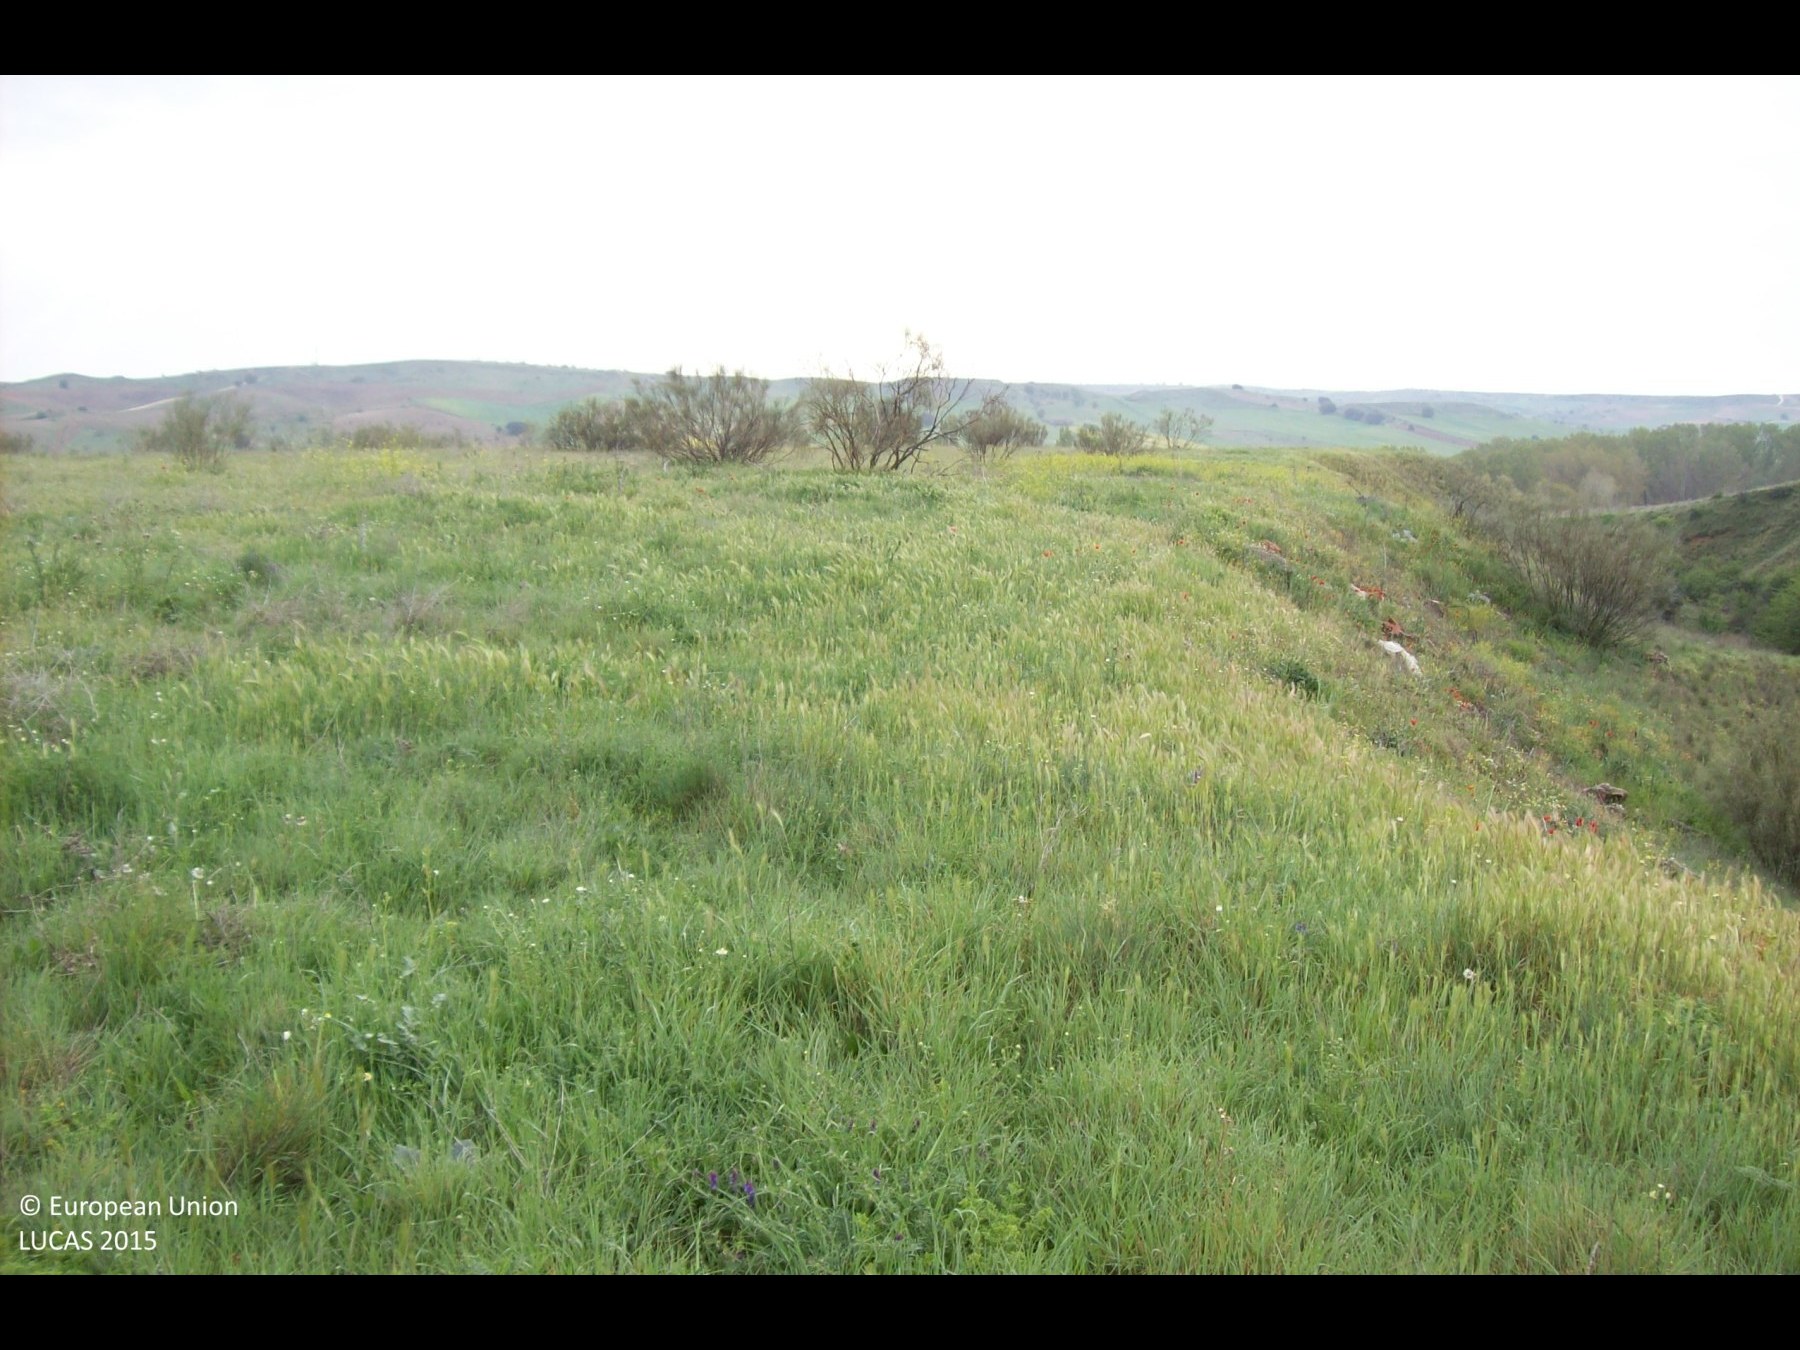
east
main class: Grassland
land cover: Grassland without tree/shrub cover
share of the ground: > 75 %
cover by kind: herbaceous plants 100 %
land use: Semi-natural and natural areas not in use
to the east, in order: Grassland without tree/shrub cover; Grassland with sparse tree/shrub cover; Shrubland without tree cover; Grassland with sparse tree/shrub cover
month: April
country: ES
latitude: 40.6696
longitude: -3.6081
